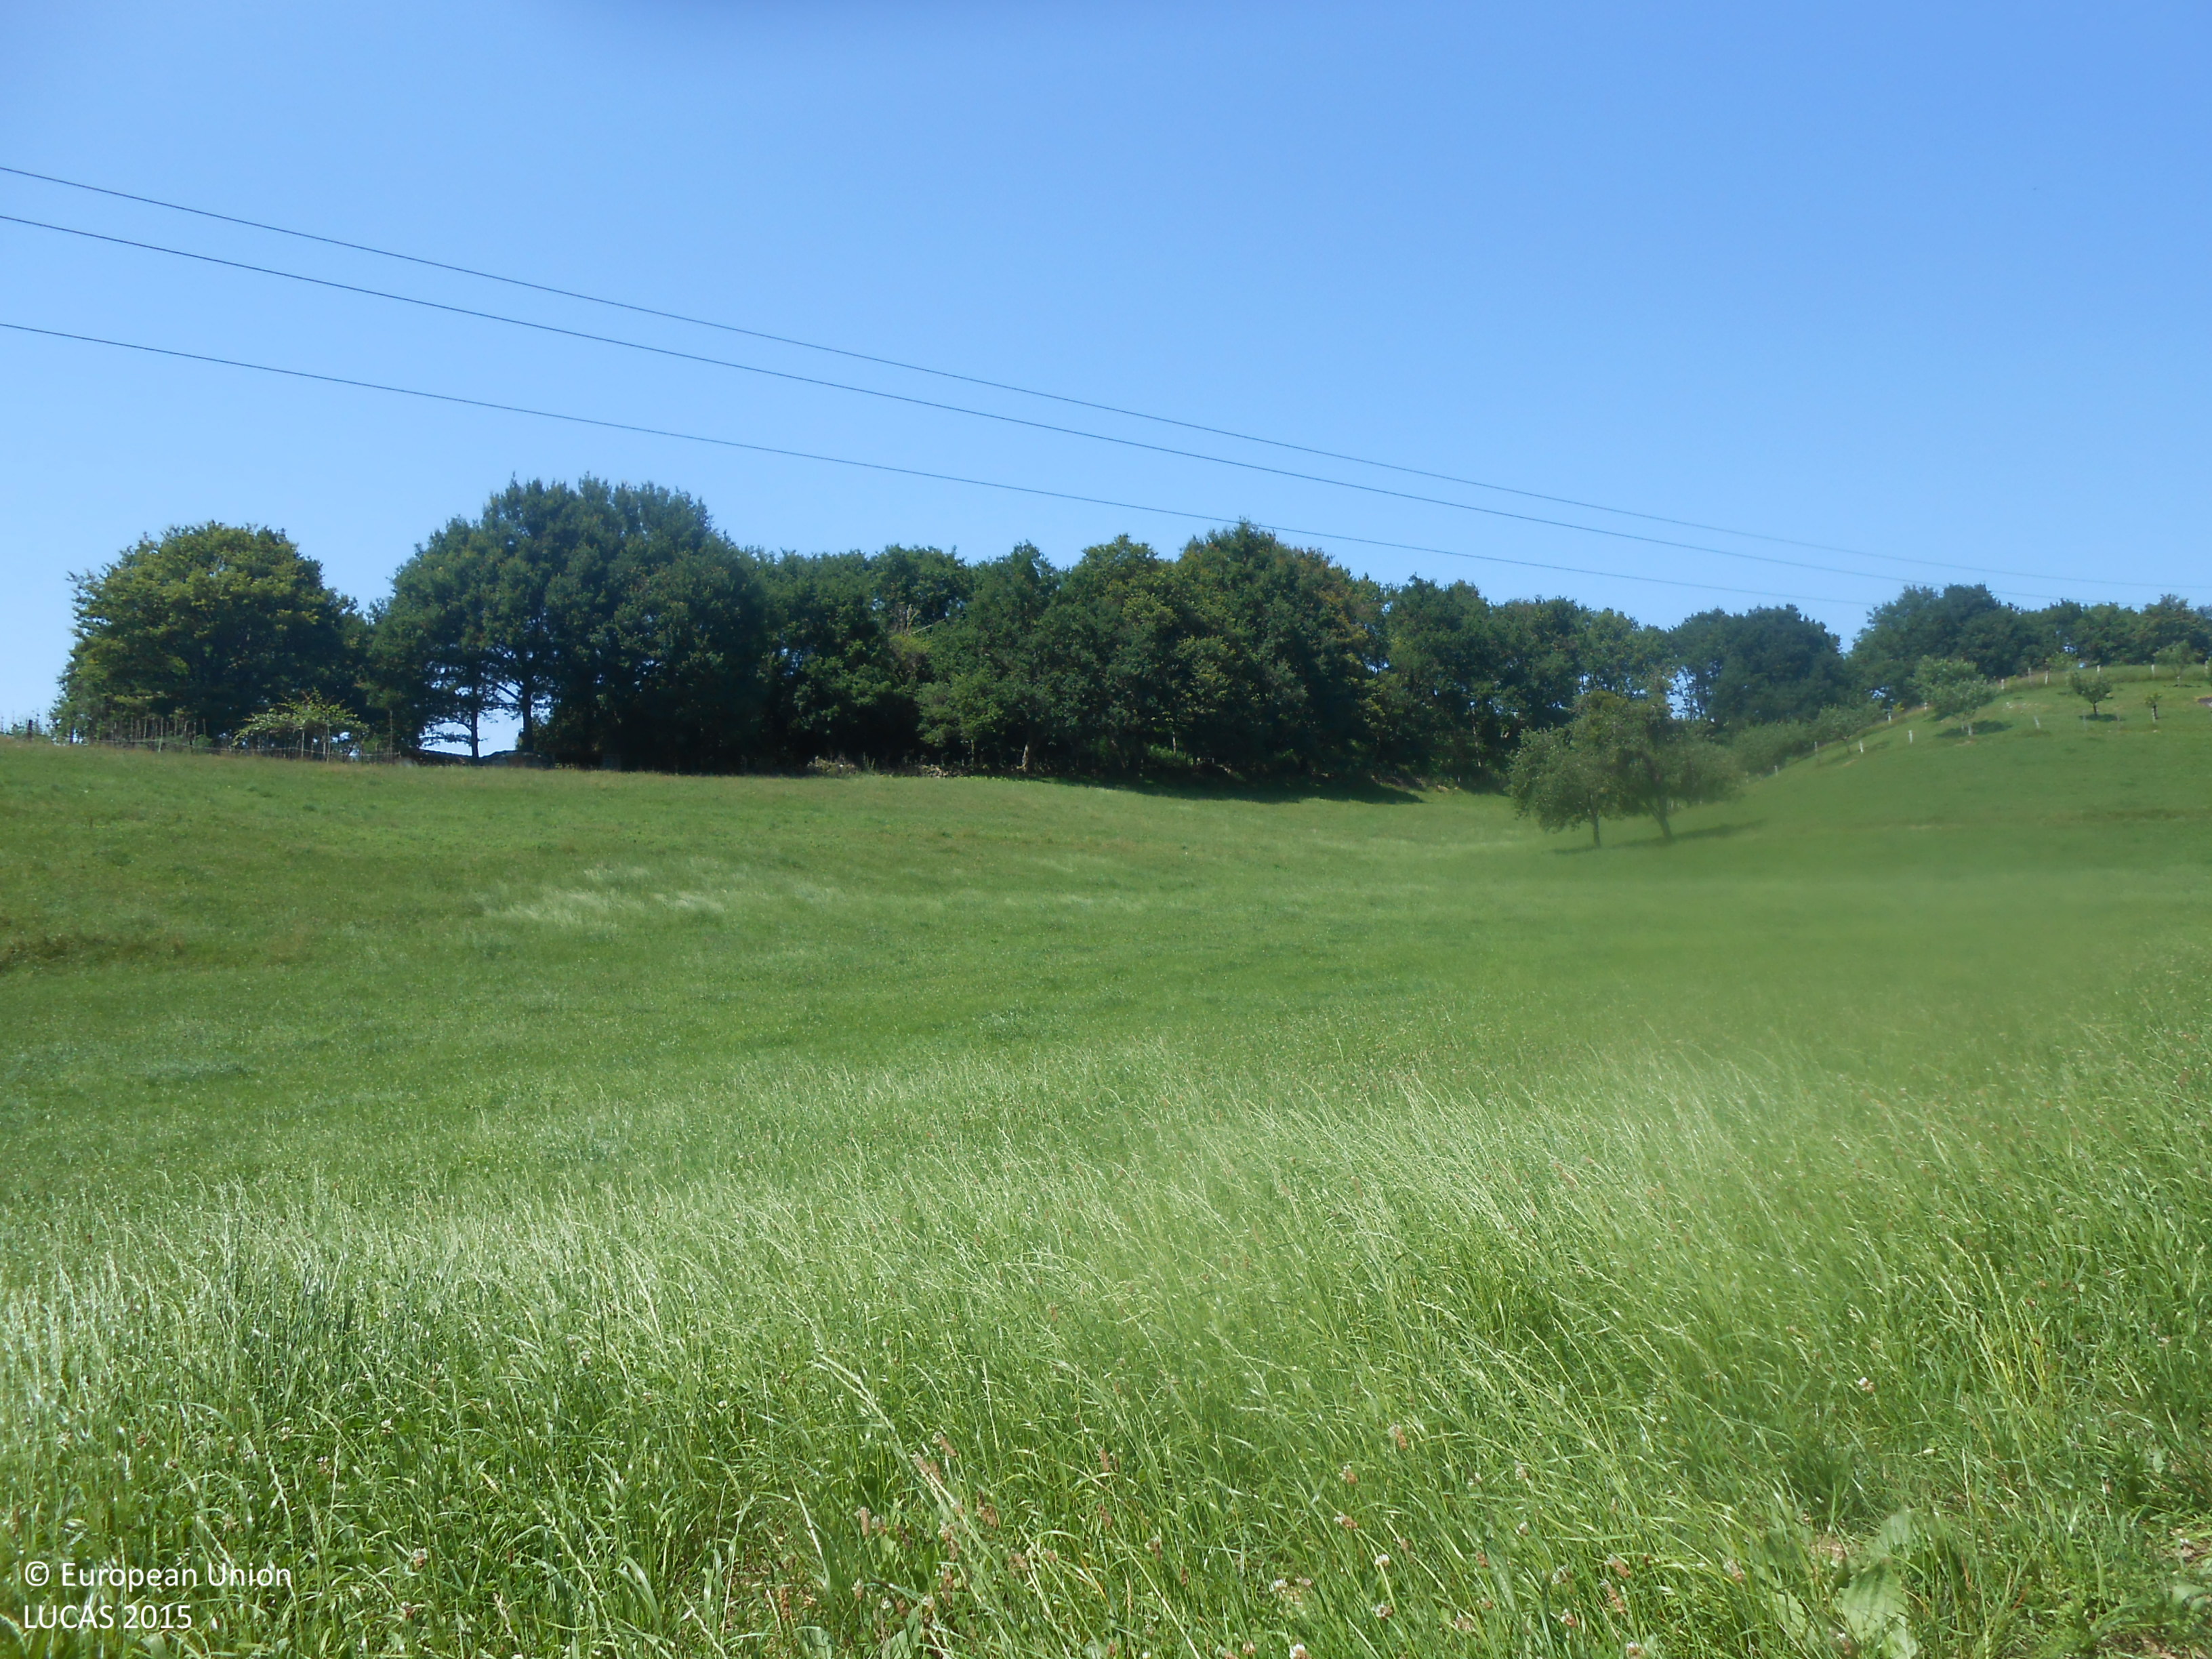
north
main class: Grassland
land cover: Grassland without tree/shrub cover
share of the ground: > 75 %
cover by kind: herbaceous plants 95 %, unconsolidated bare surface 5 %
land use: Agriculture (excluding fallow land and kitchen gardens)
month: June
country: ES
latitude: 43.1637
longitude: -1.4913
